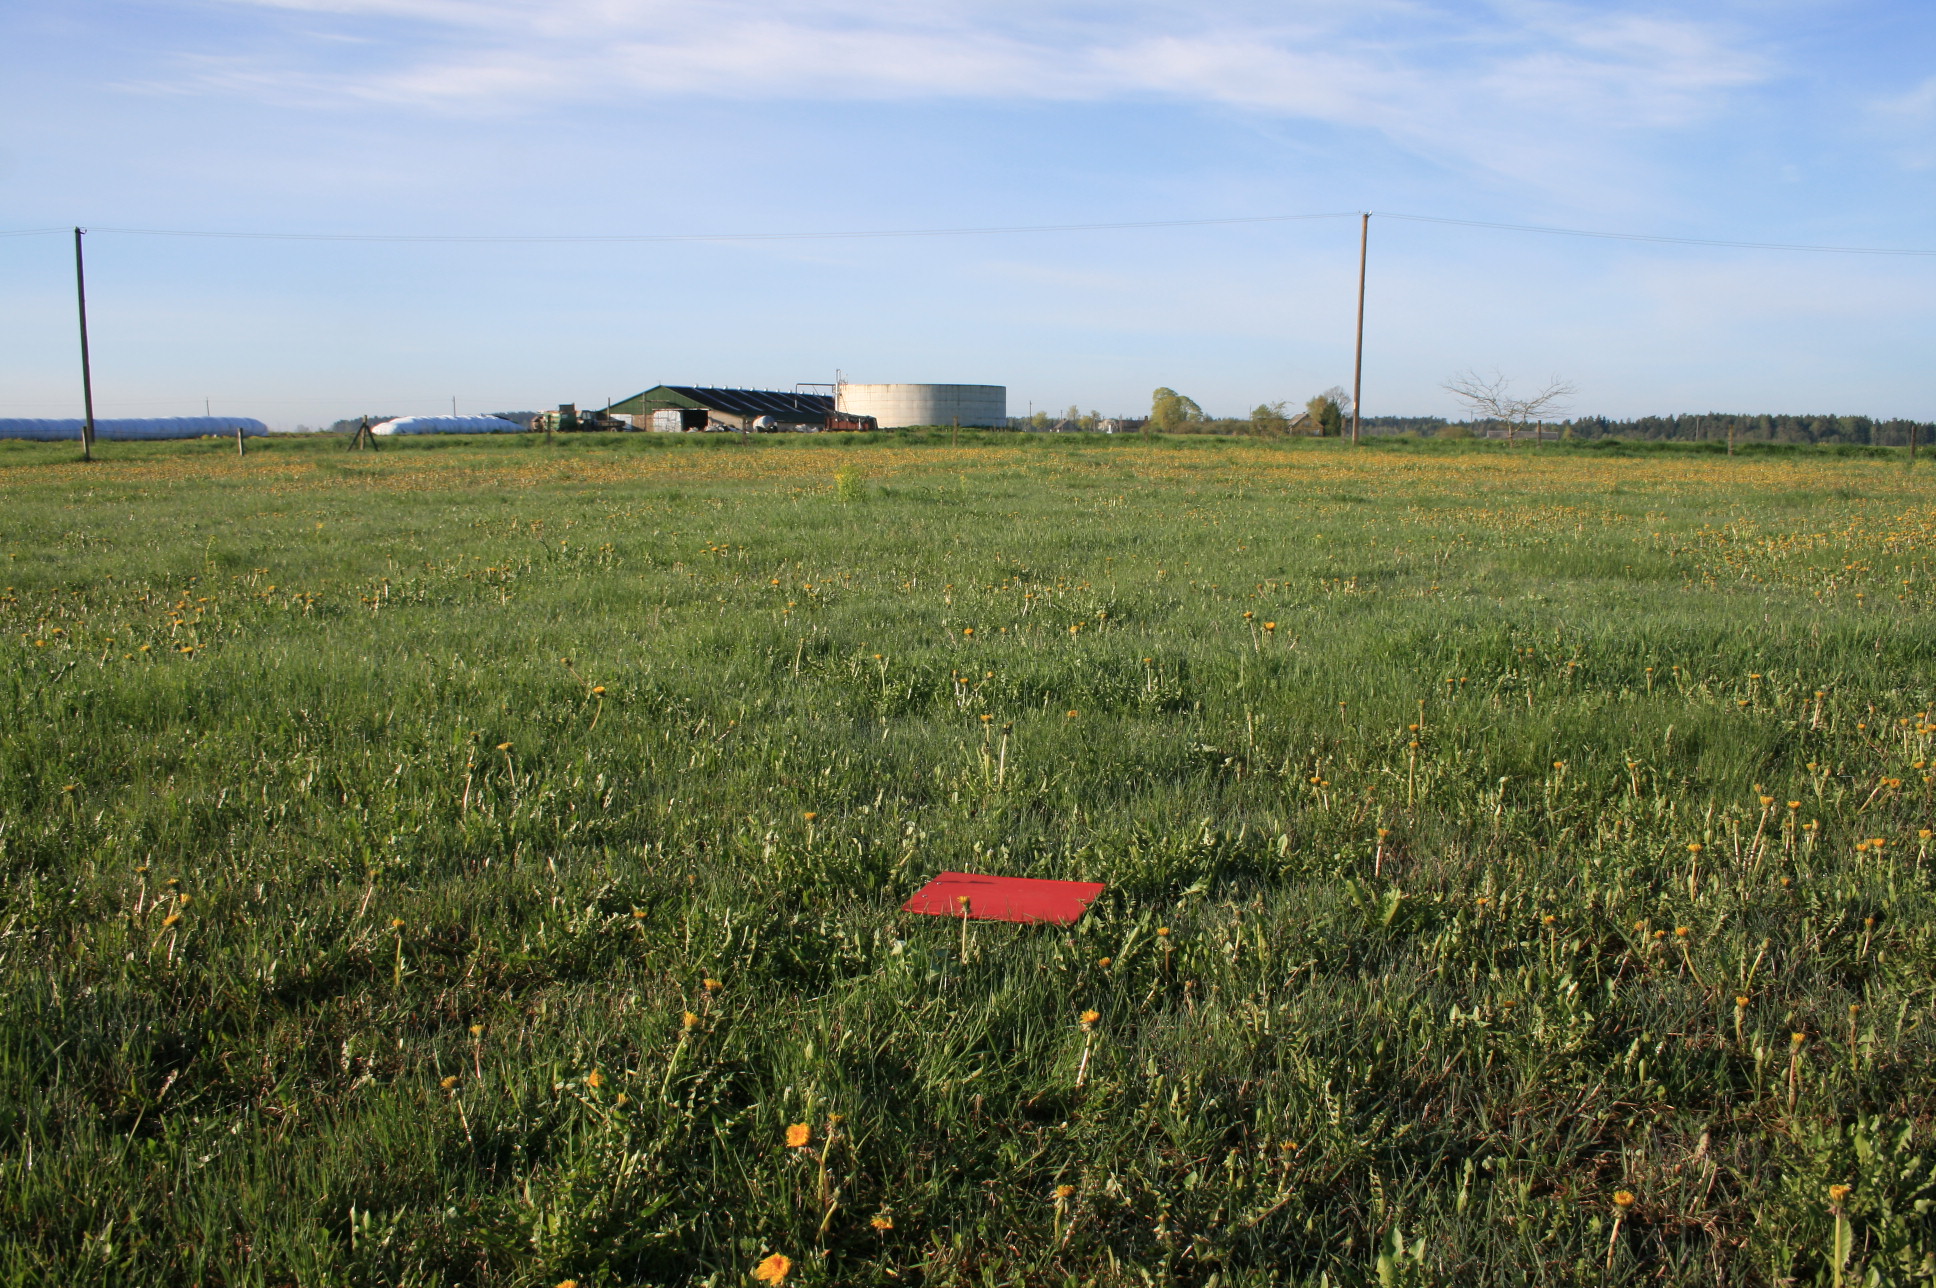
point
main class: Grassland
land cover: Grassland without tree/shrub cover
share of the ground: > 75 %
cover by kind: herbaceous plants 100 %
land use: Agriculture (excluding fallow land and kitchen gardens)
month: May
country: LT
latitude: 56.1399
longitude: 21.5181
